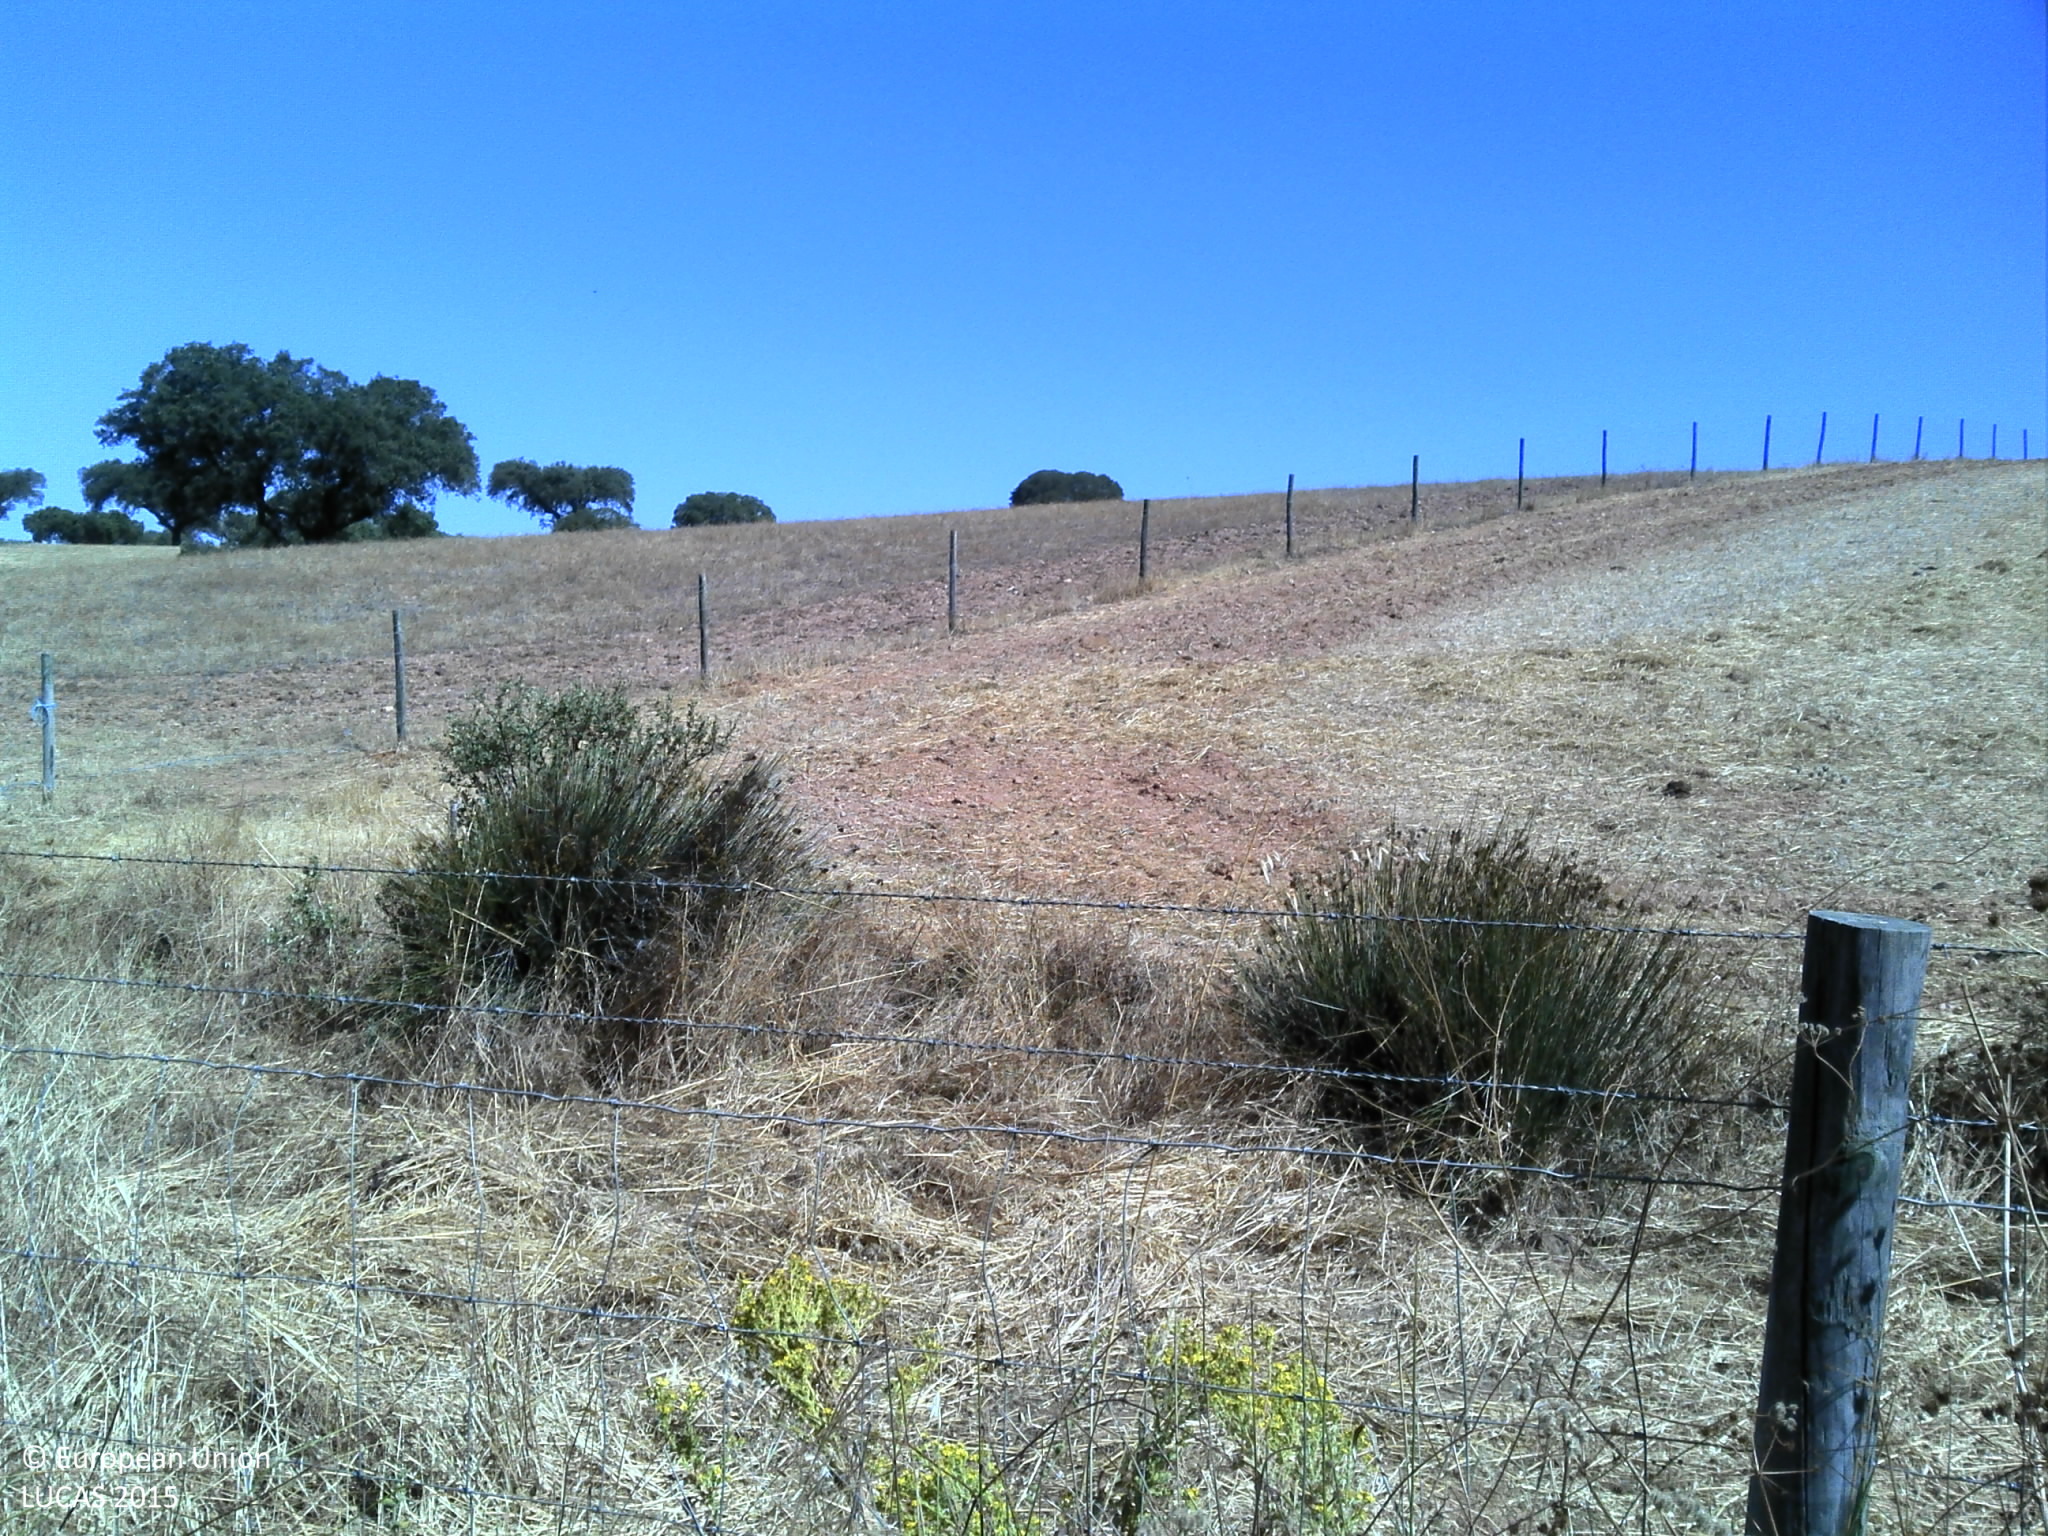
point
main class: Grassland
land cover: Grassland without tree/shrub cover
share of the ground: > 75 %
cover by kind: herbaceous plants 85 %, unconsolidated bare surface 15 %
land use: Agriculture (excluding fallow land and kitchen gardens)
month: August
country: PT
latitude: 37.8820
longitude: -7.8176
